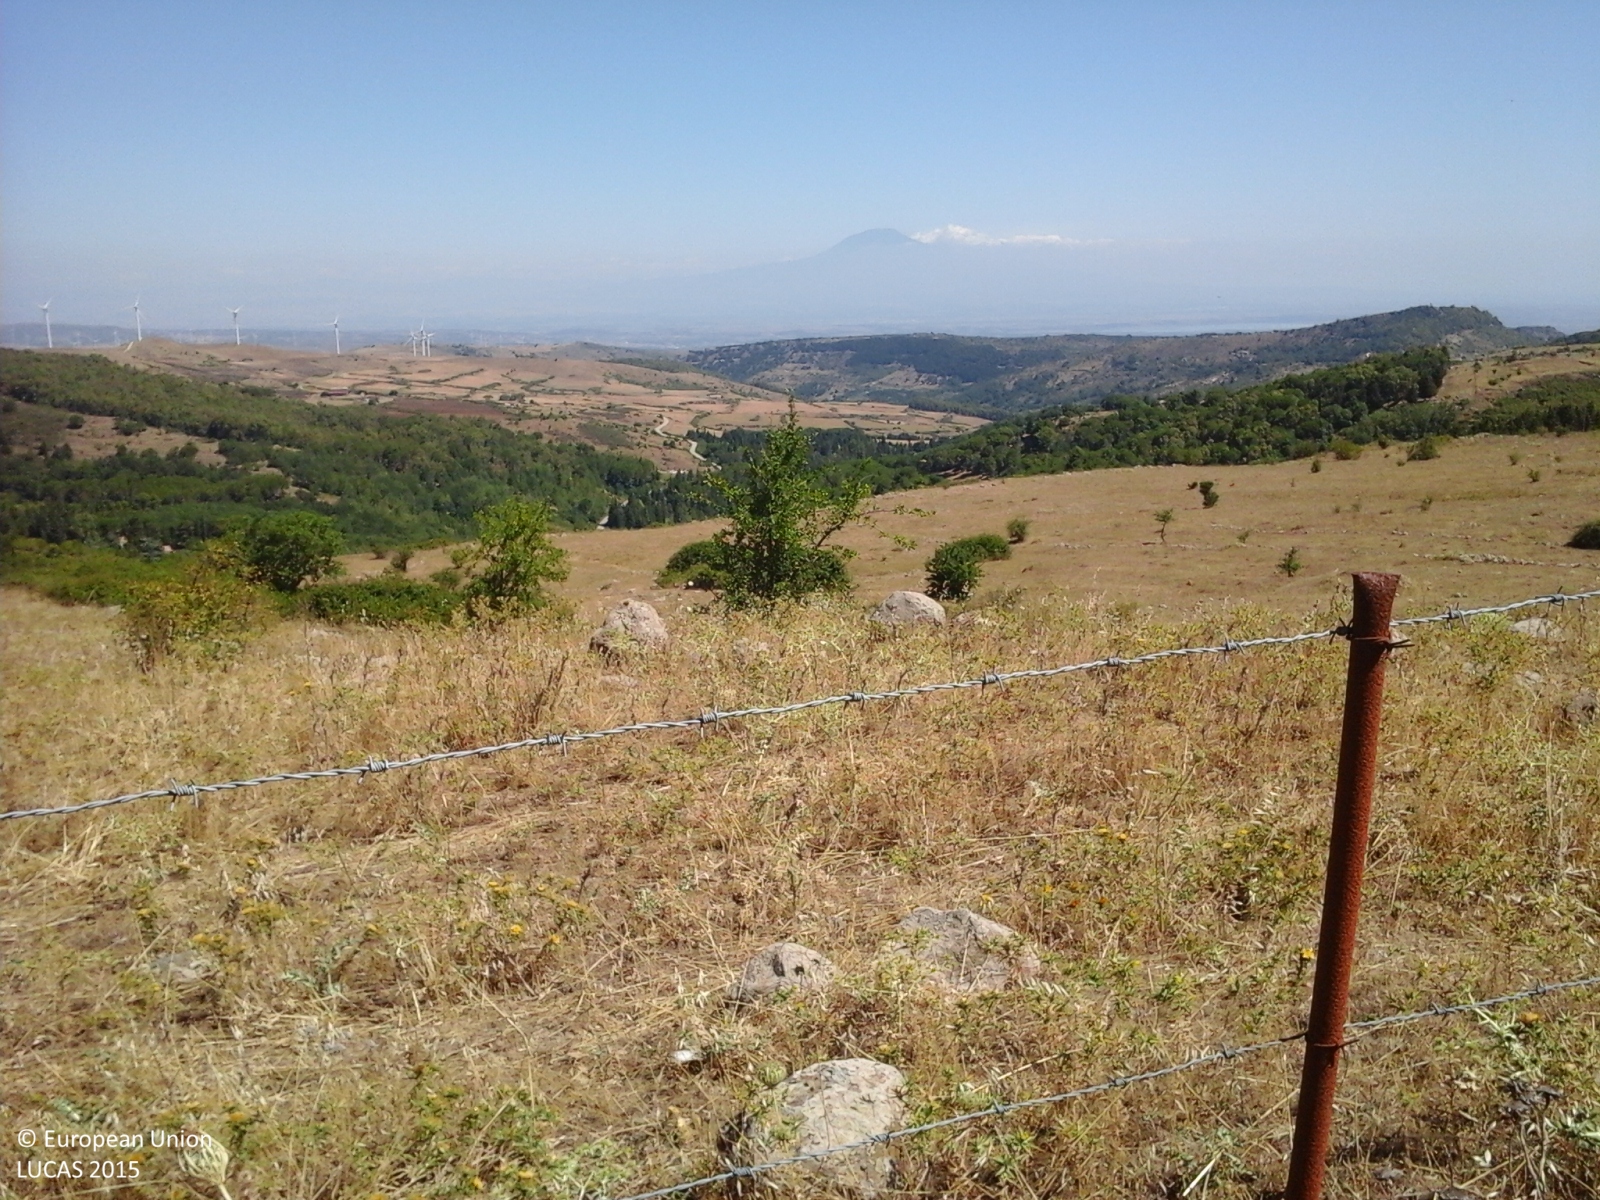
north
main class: Grassland
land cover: Grassland without tree/shrub cover
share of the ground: > 75 %
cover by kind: herbaceous plants 90 %, consolidated bare surface 10 %
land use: Agriculture (excluding fallow land and kitchen gardens)
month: July
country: IT
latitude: 37.1152
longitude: 14.8358
